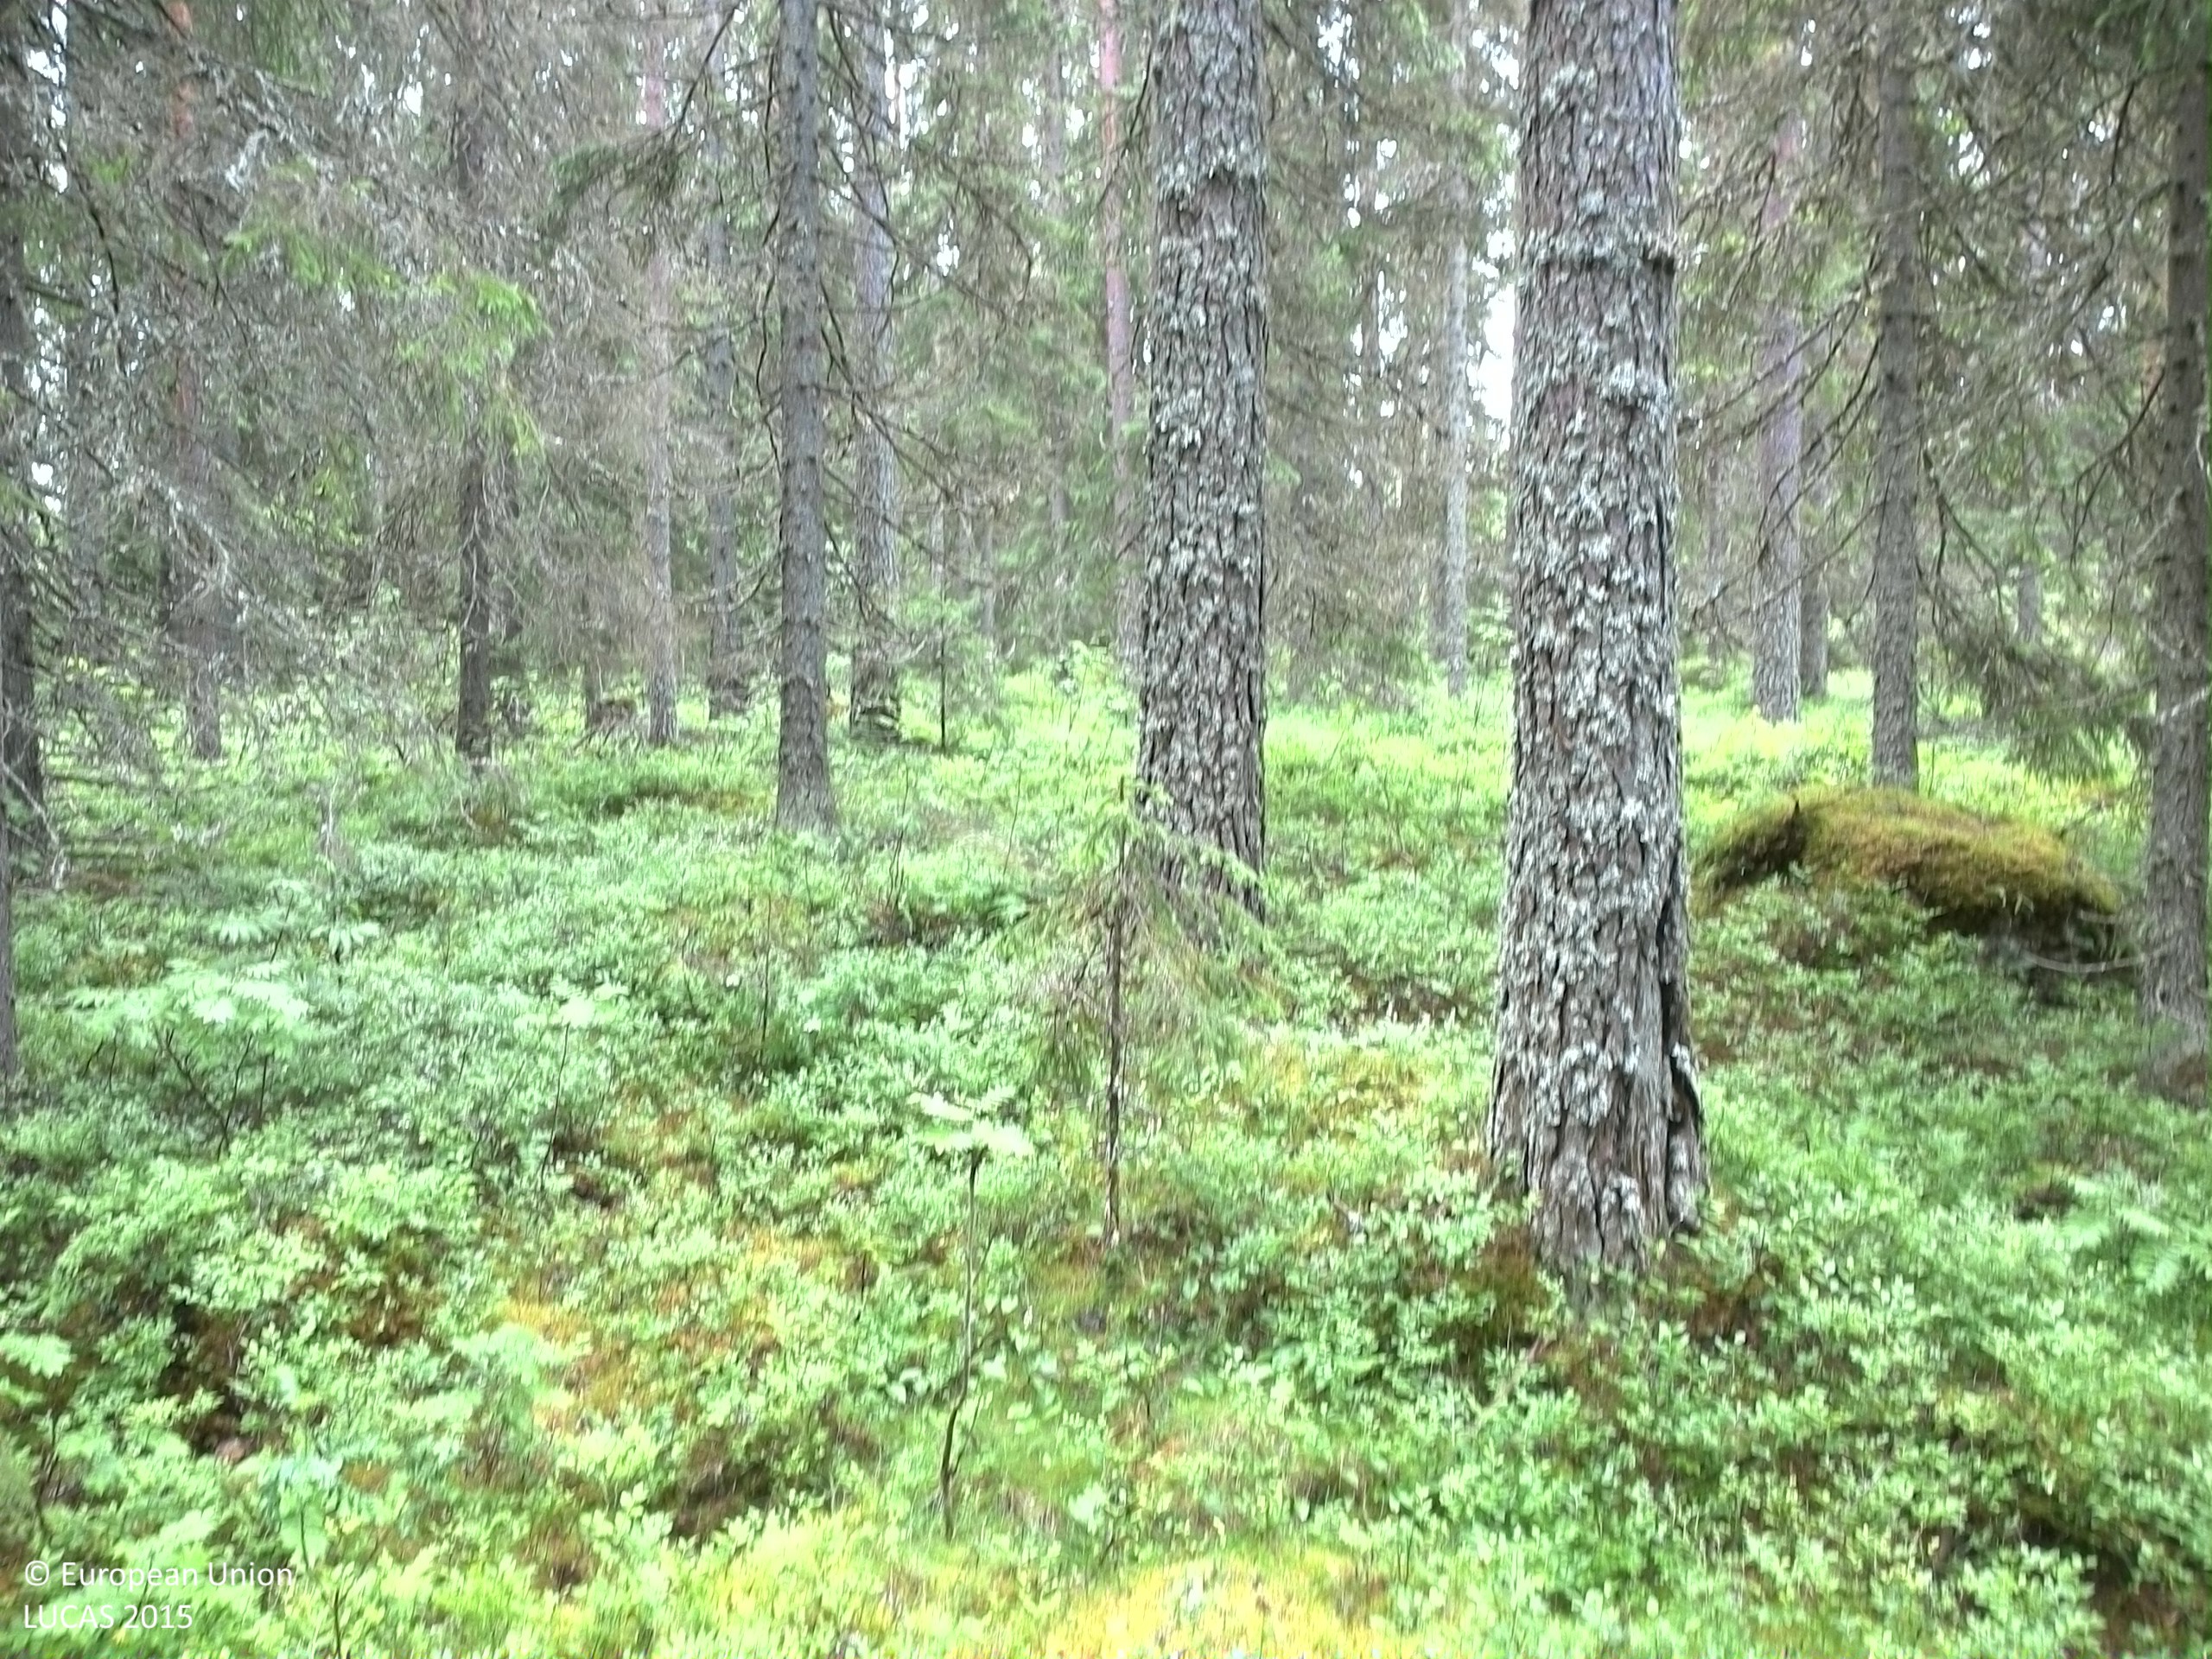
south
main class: Woodland
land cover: Spruce dominated coniferous woodland
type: boreal forest
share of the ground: 50 - 75 %
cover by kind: coniferous forest trees 60 %, shrubs 30 %, broadleaved forest trees 5 %, lichens and mosses 5 %
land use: Forestry
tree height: > 5 m
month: July
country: SE
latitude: 63.5619
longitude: 18.6527
